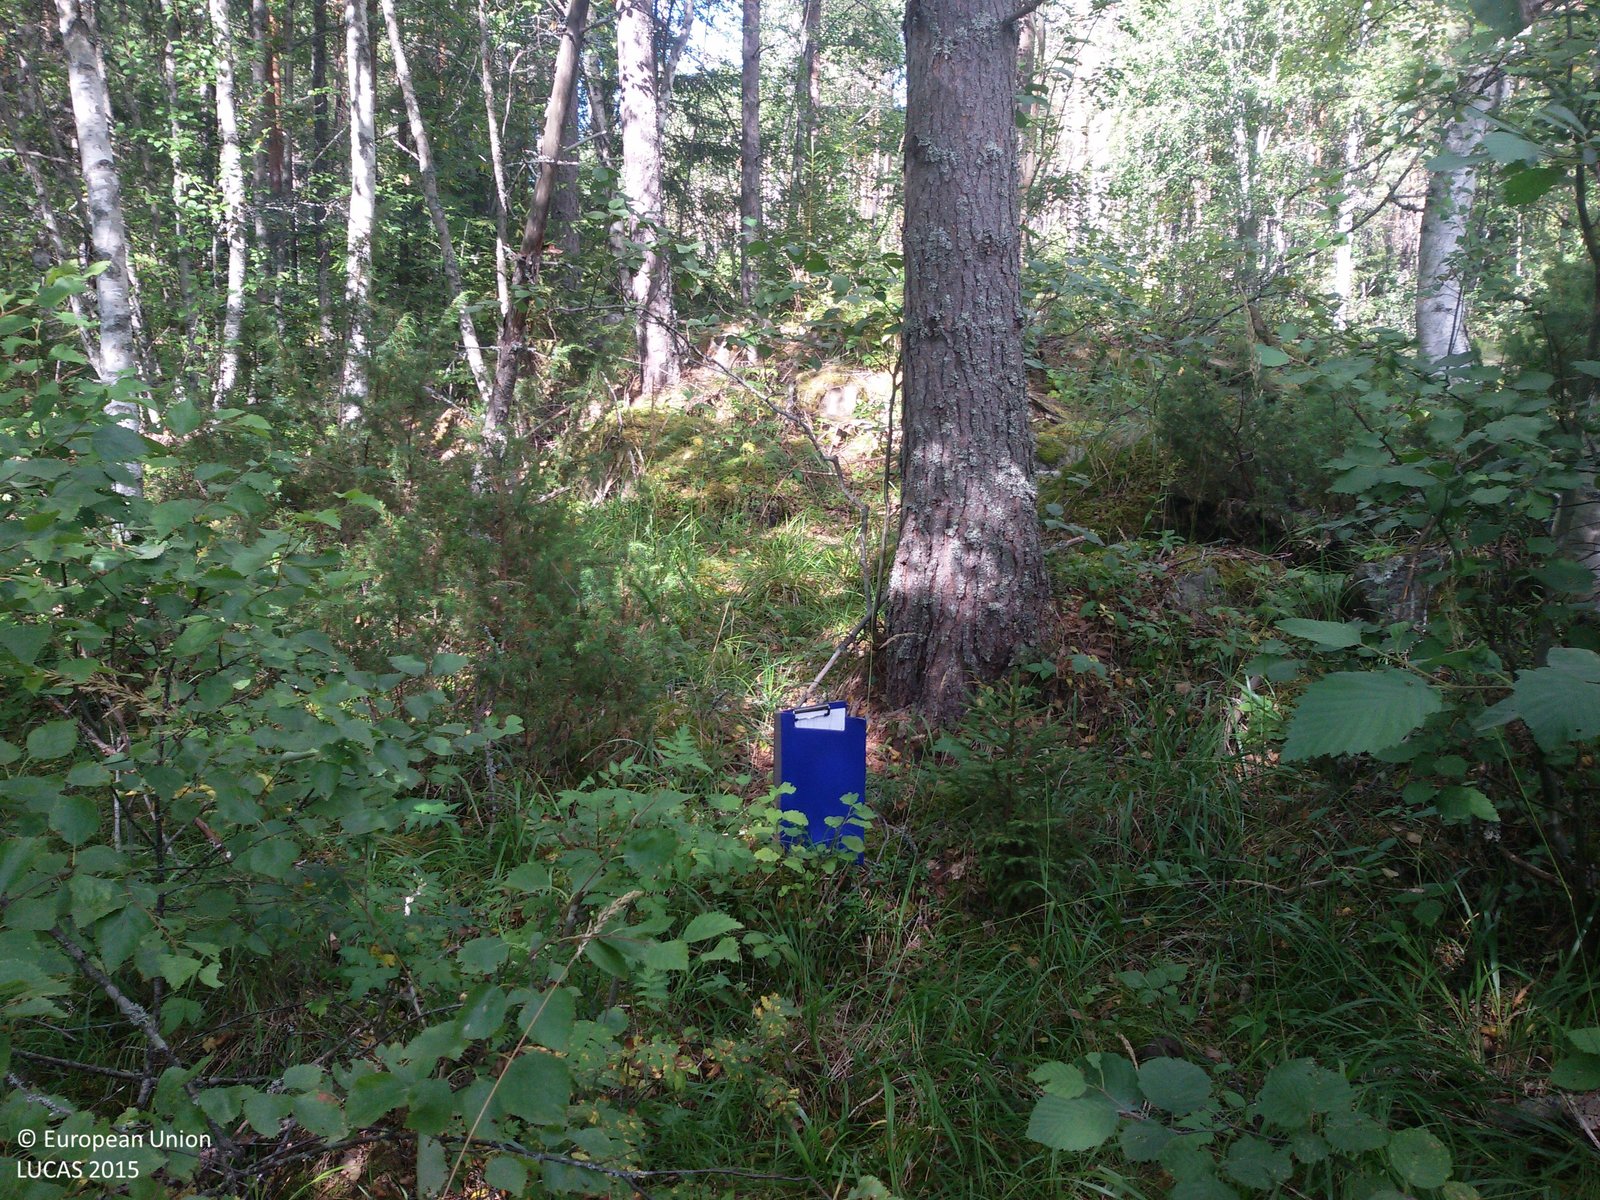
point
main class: Woodland
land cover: Pine dominated mixed woodland
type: boreal forest
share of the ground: > 75 %
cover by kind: coniferous forest trees 50 %, broadleaved forest trees 30 %, herbaceous plants 15 %, lichens and mosses 5 %
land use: Forestry
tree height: > 5 m
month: August
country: SE
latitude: 60.8148
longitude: 15.9247
